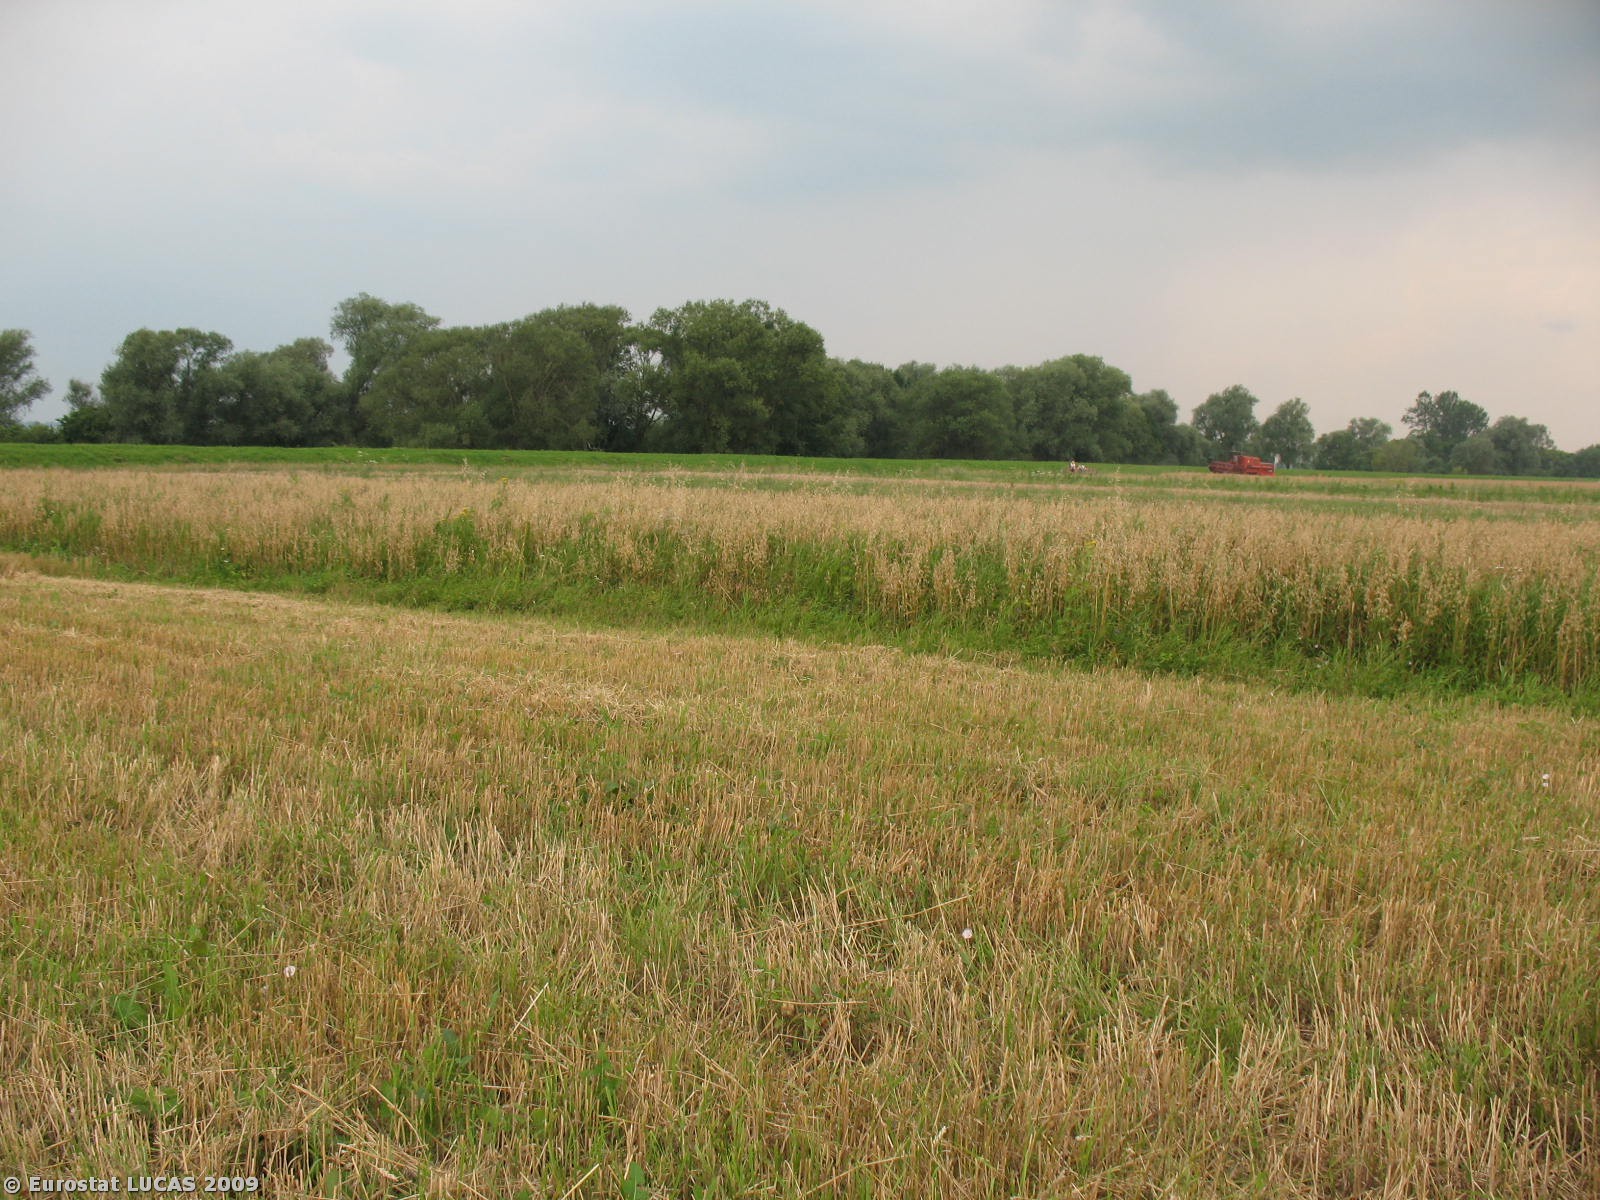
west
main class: Cropland
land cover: Common wheat
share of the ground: < 10 %
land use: Agriculture (excluding fallow land and kitchen gardens)
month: August
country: PL
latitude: 49.6054
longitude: 21.9707
